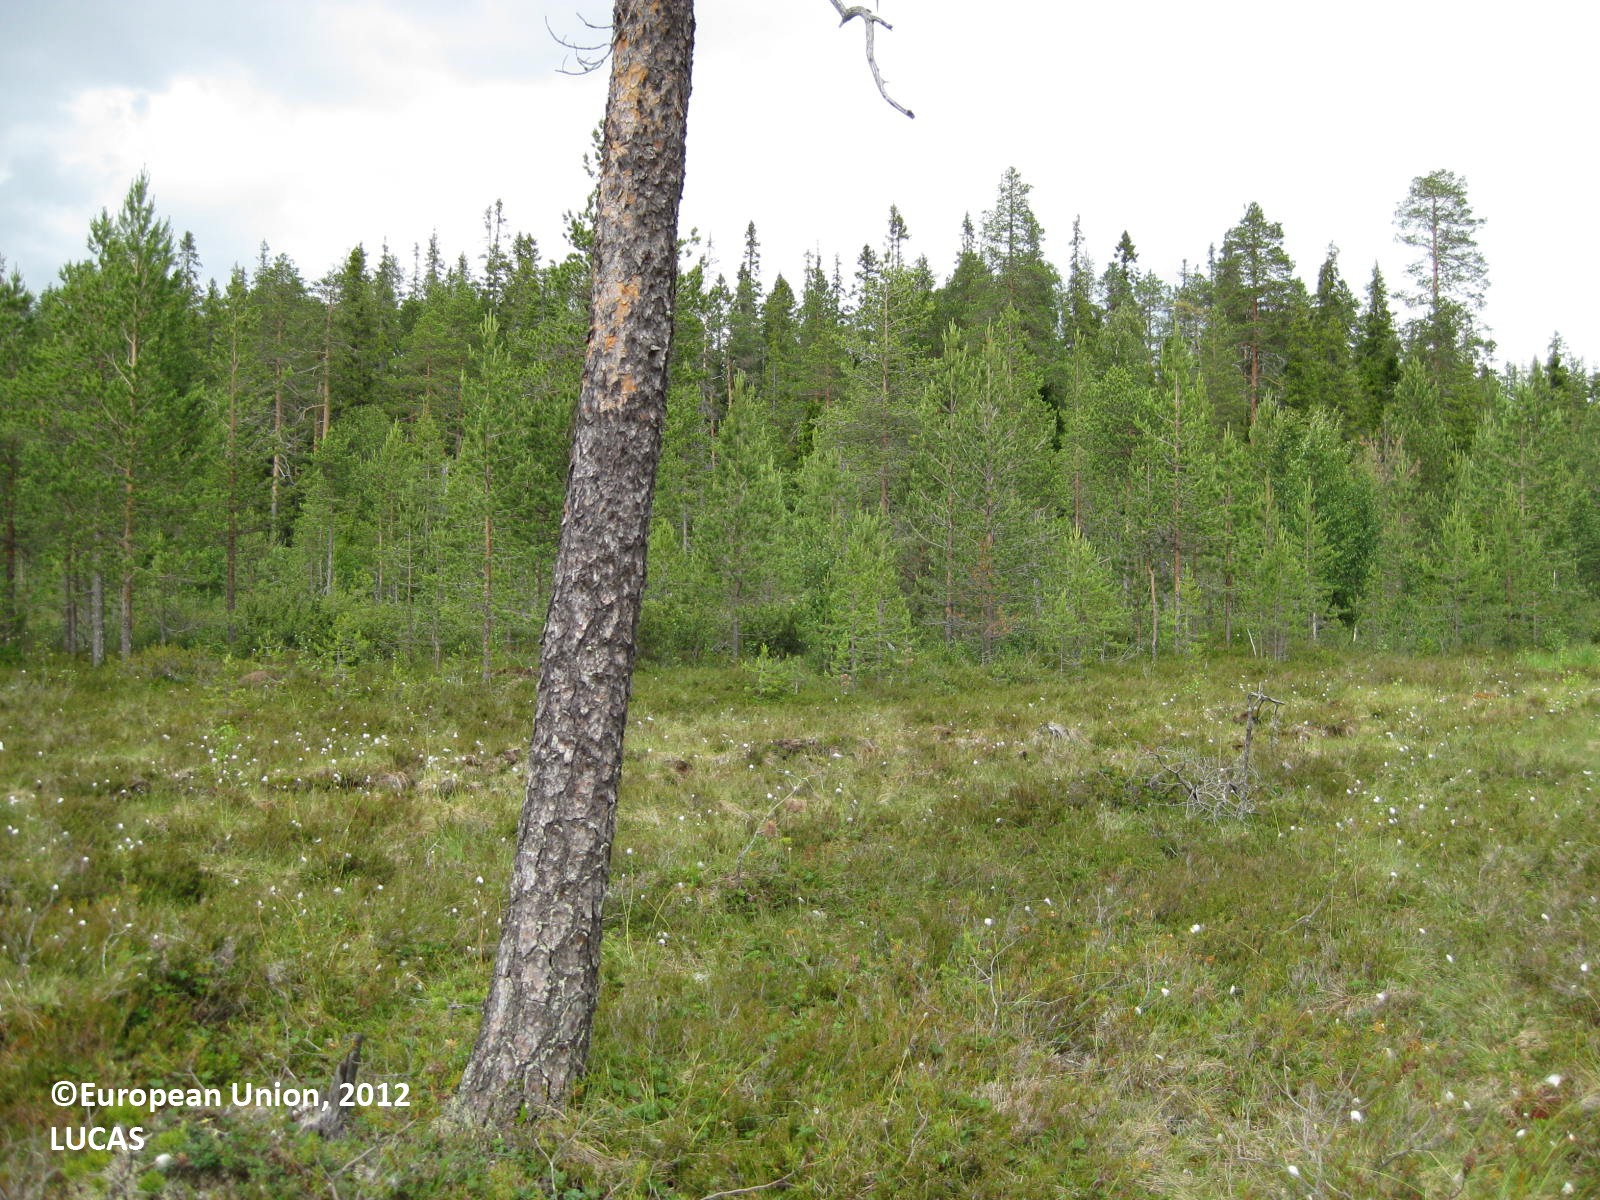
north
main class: Wetlands
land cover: Peatbogs
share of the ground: < 10 %
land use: Semi-natural and natural areas not in use
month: July
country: FI
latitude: 65.4436
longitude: 28.3359
